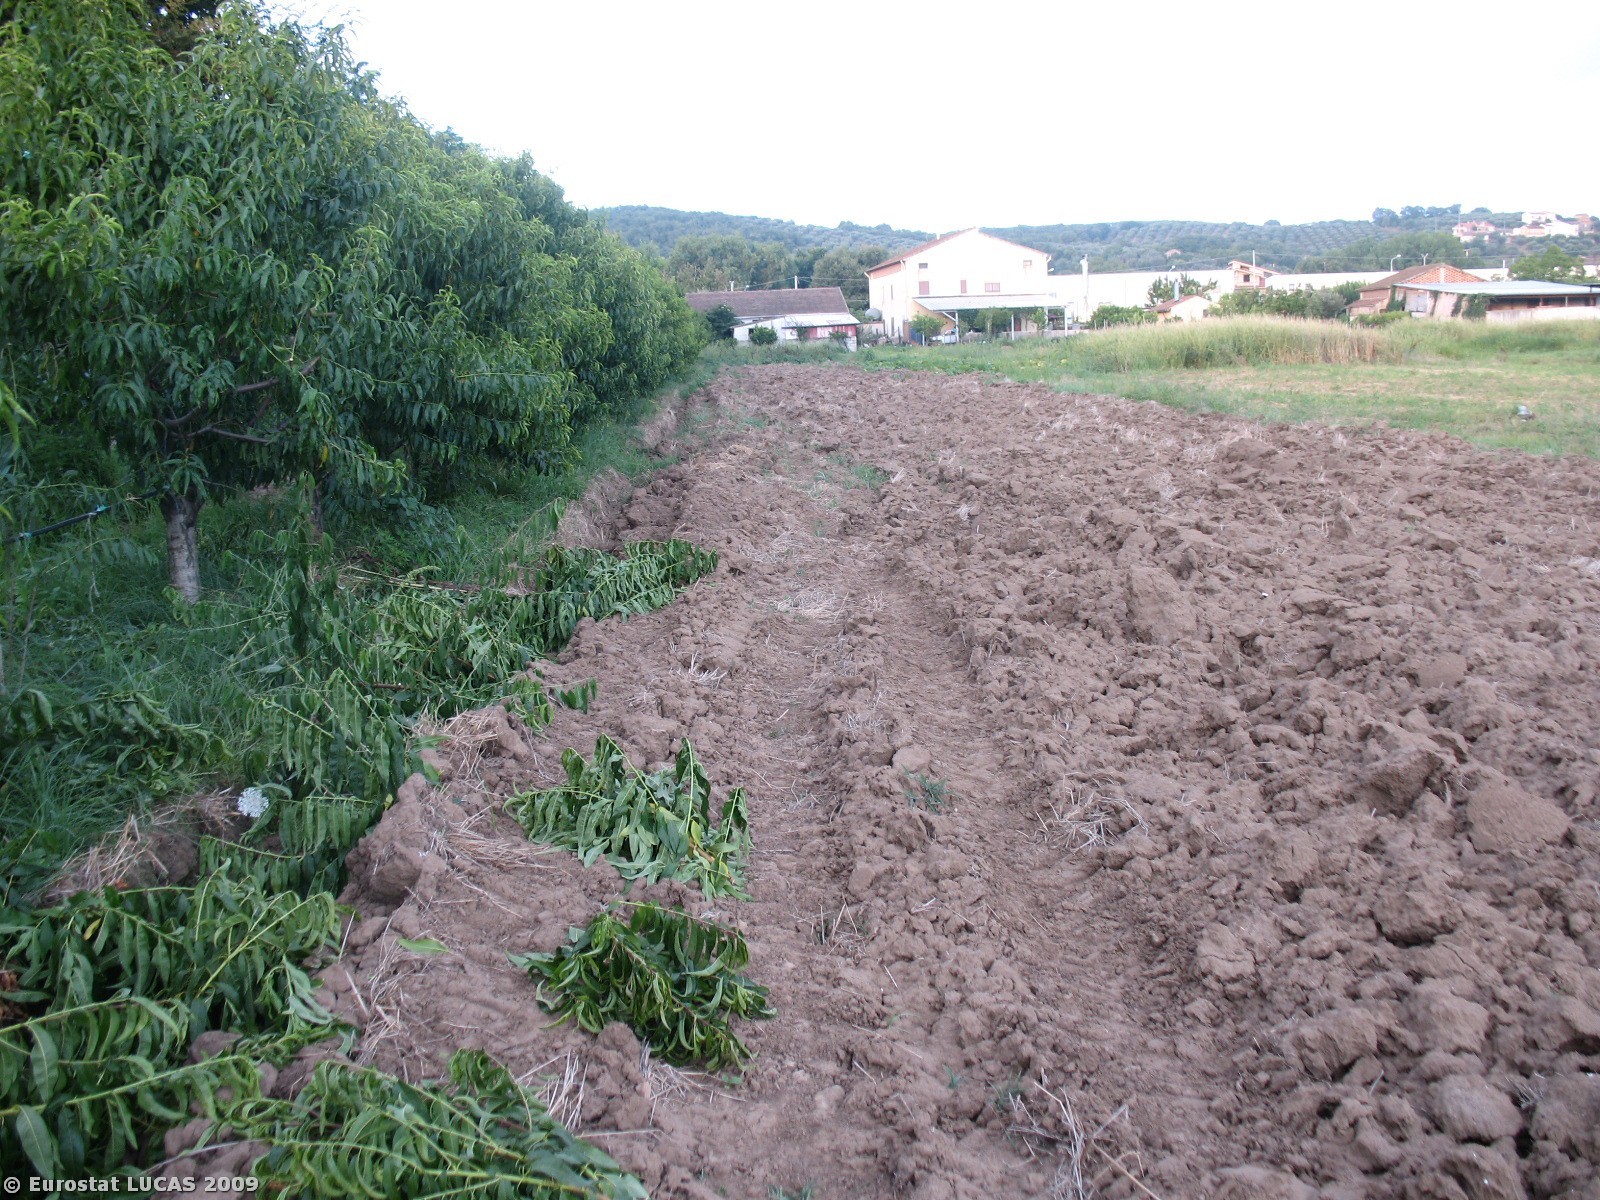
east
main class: Cropland
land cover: Temporary grasslands
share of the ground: < 10 %
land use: Agriculture (excluding fallow land and kitchen gardens)
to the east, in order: Temporary grasslands; Tracks; Spontaneously vegetated surfaces; Artificial constructions in urban areas; Grass margins; Bare land; Abandoned hedges; Fences; Paved roads, cycling and walking lanes; Fences; Abandoned hedges; Tracks; Ditches and canals; Bare land
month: July
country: IT
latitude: 40.4991
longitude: 15.0642
